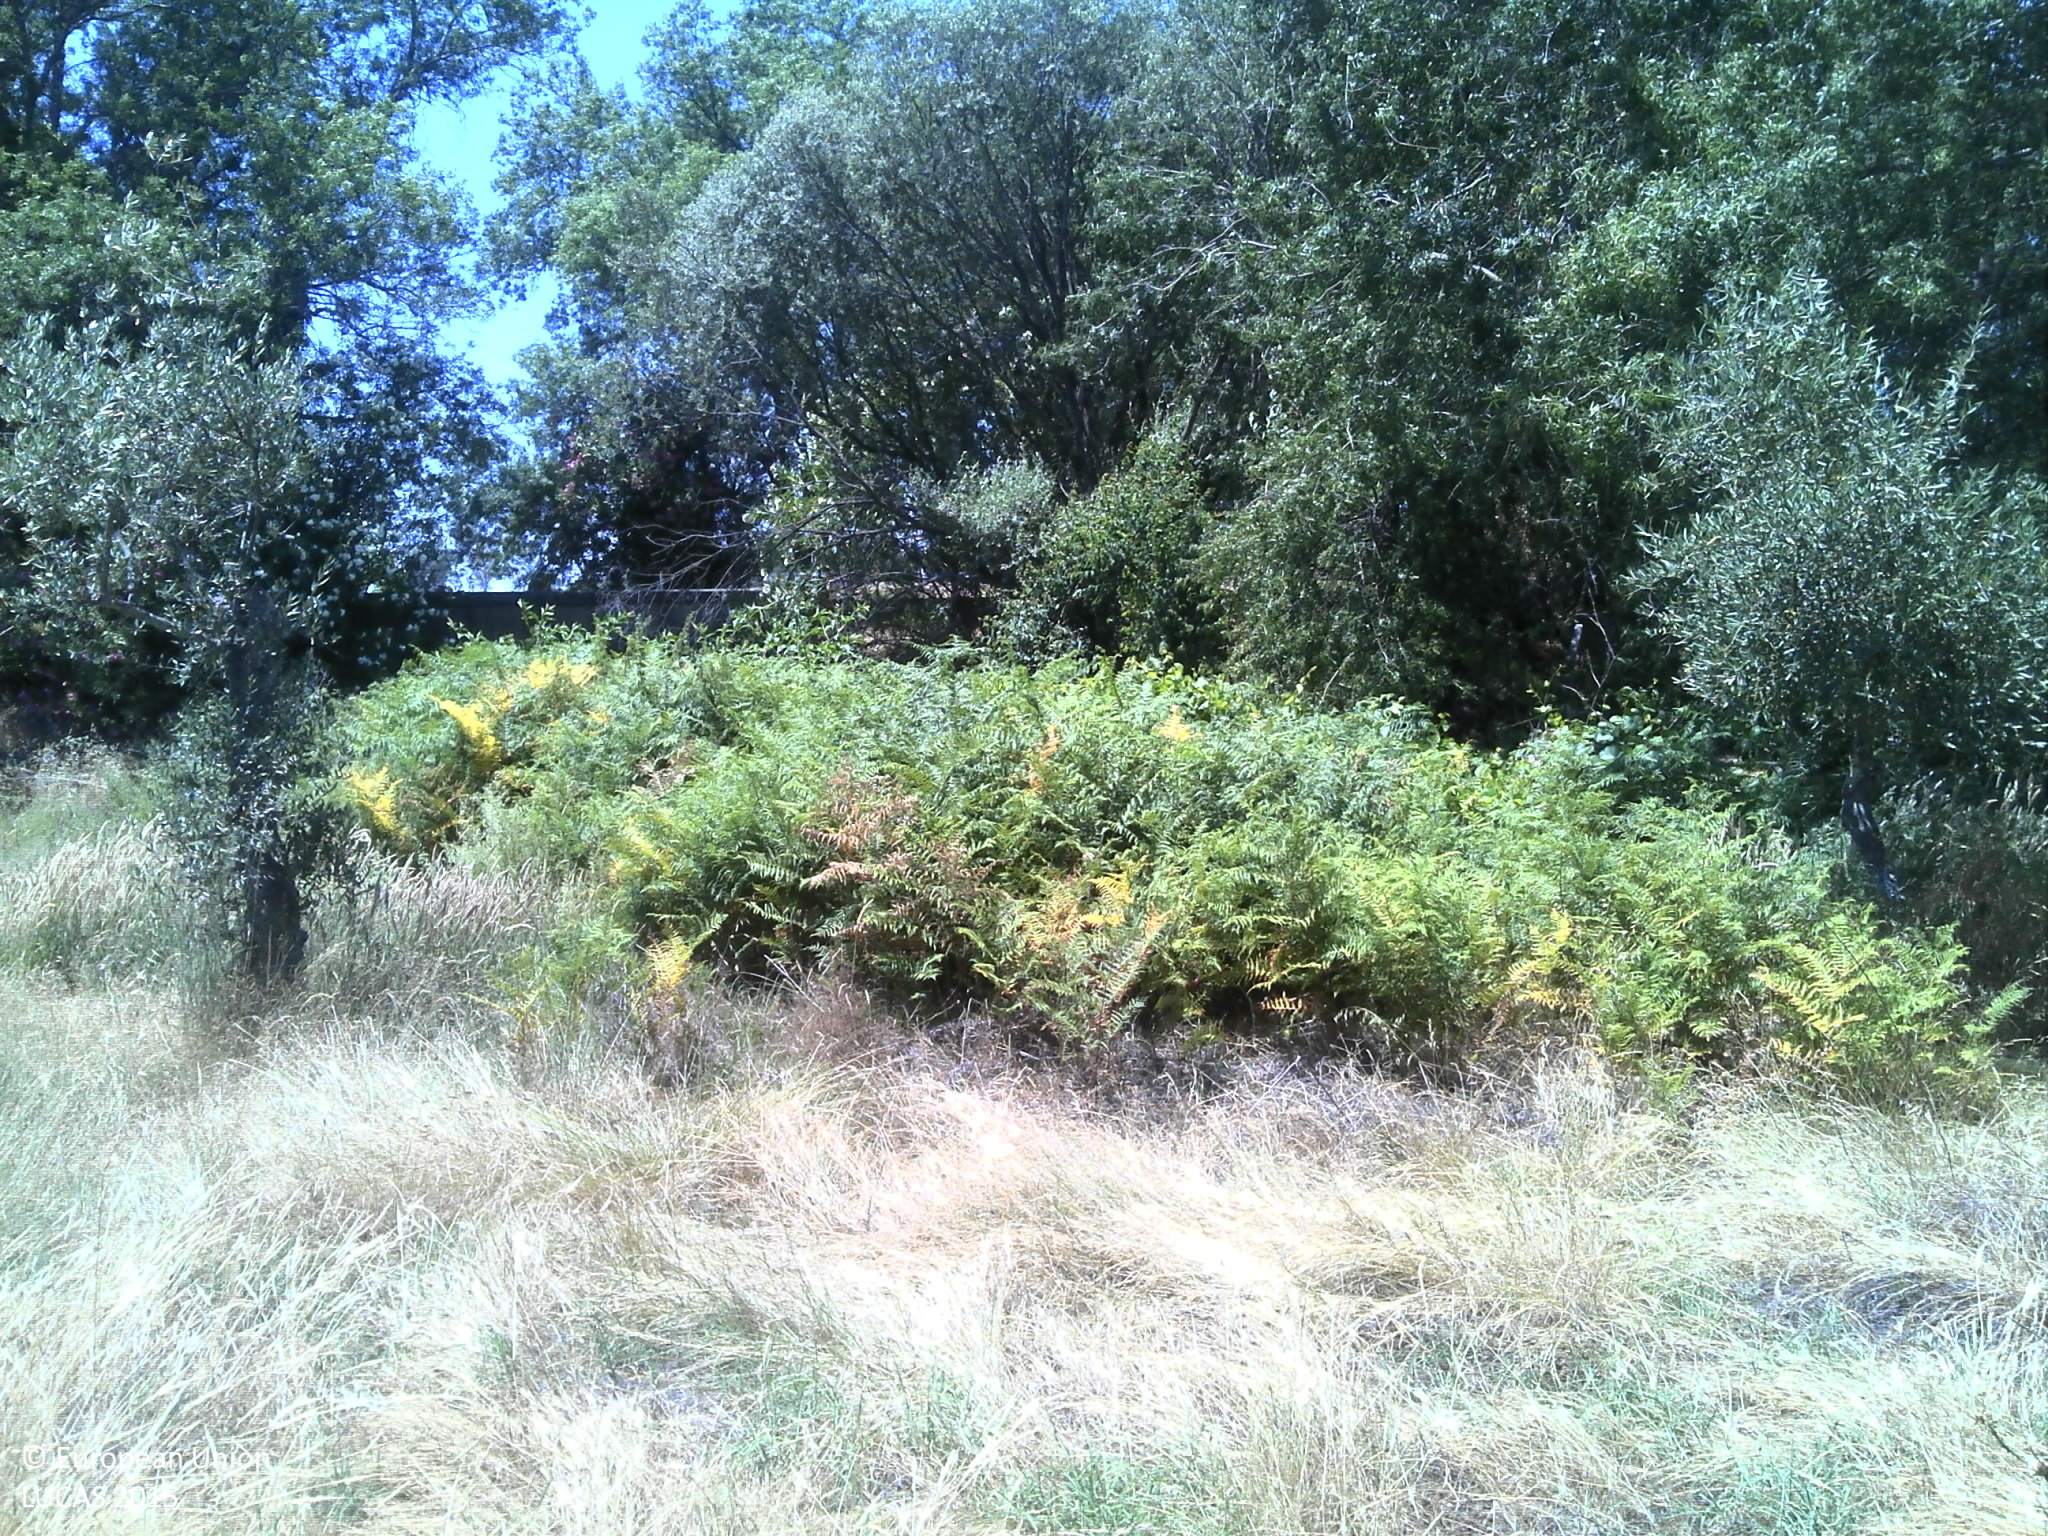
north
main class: Cropland
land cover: Olive groves
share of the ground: 25 - 50 %
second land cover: Grassland without tree/shrub cover
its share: 50 - 75 %
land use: Agriculture (excluding fallow land and kitchen gardens)
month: June
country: PT
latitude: 39.9168
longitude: -7.4014
